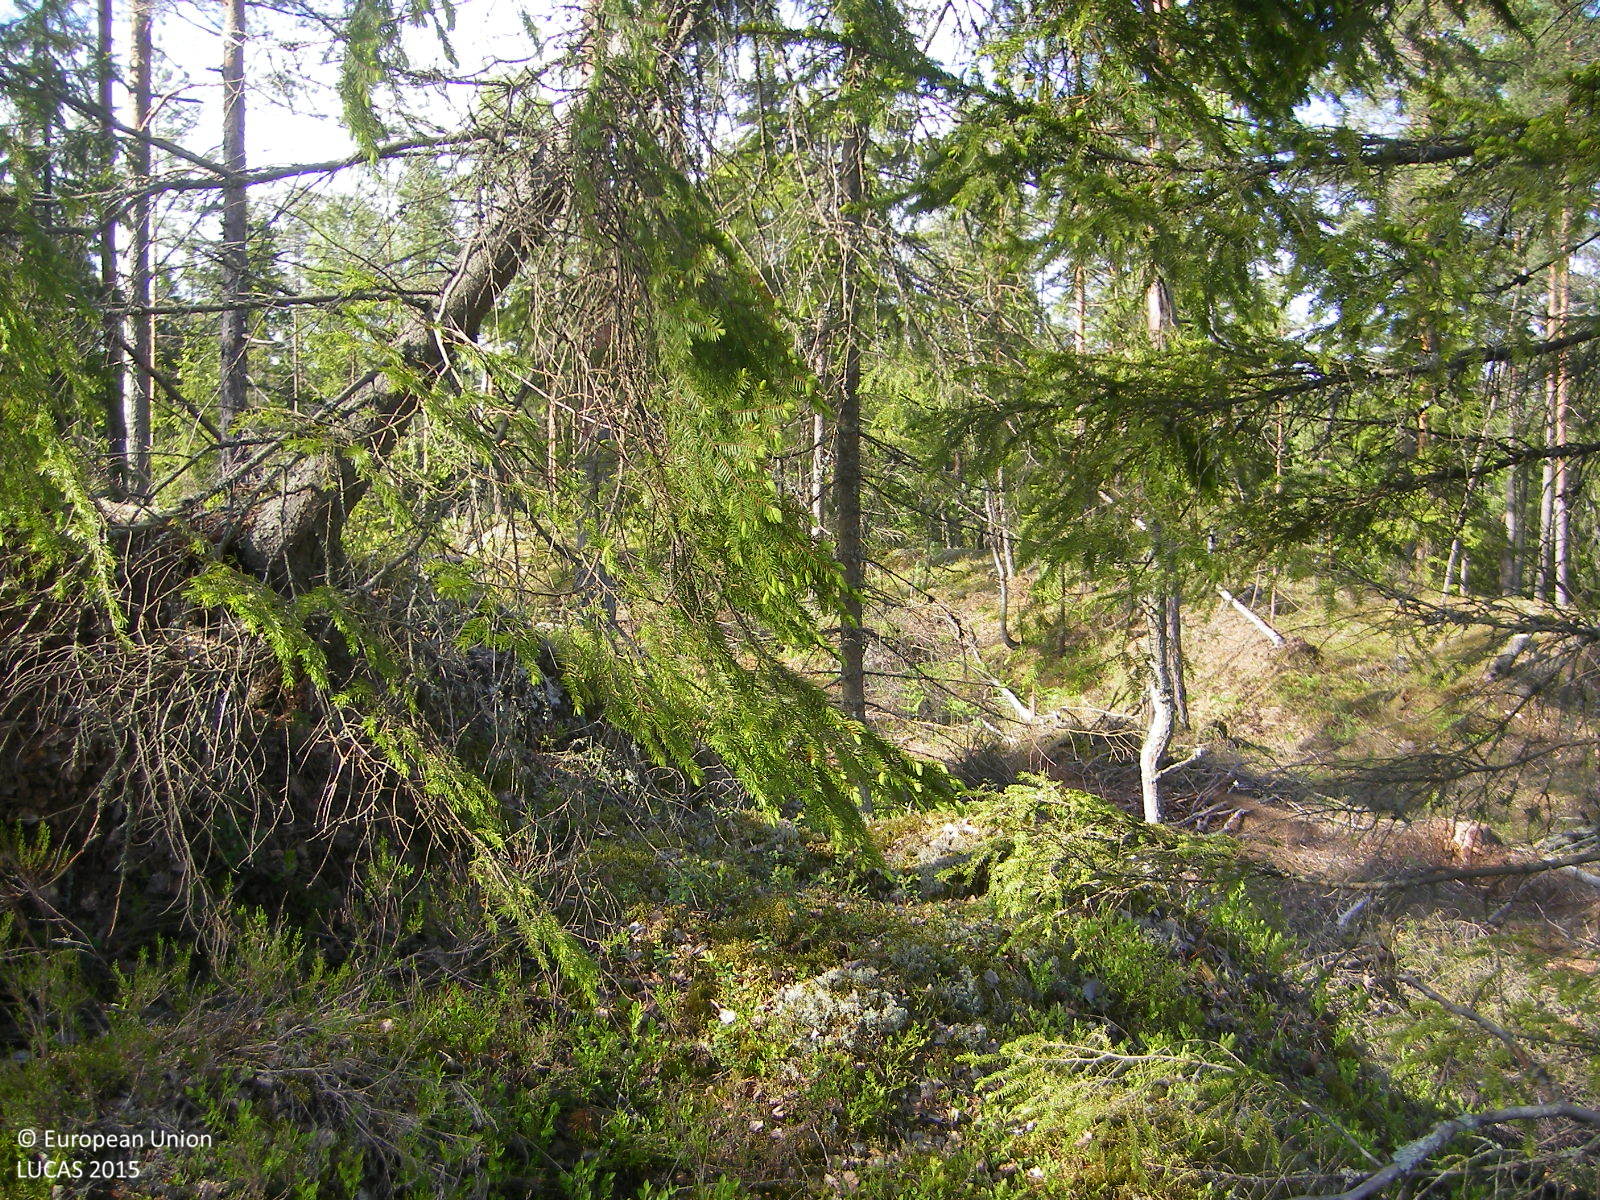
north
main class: Woodland
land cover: Pine dominated coniferous woodland
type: boreal forest
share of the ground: 10 - 25 %
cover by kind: shrubs 45 %, unconsolidated bare surface 35 %, coniferous forest trees 20 %
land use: Forestry
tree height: > 5 m
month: June
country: FI
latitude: 60.2397
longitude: 24.6136
